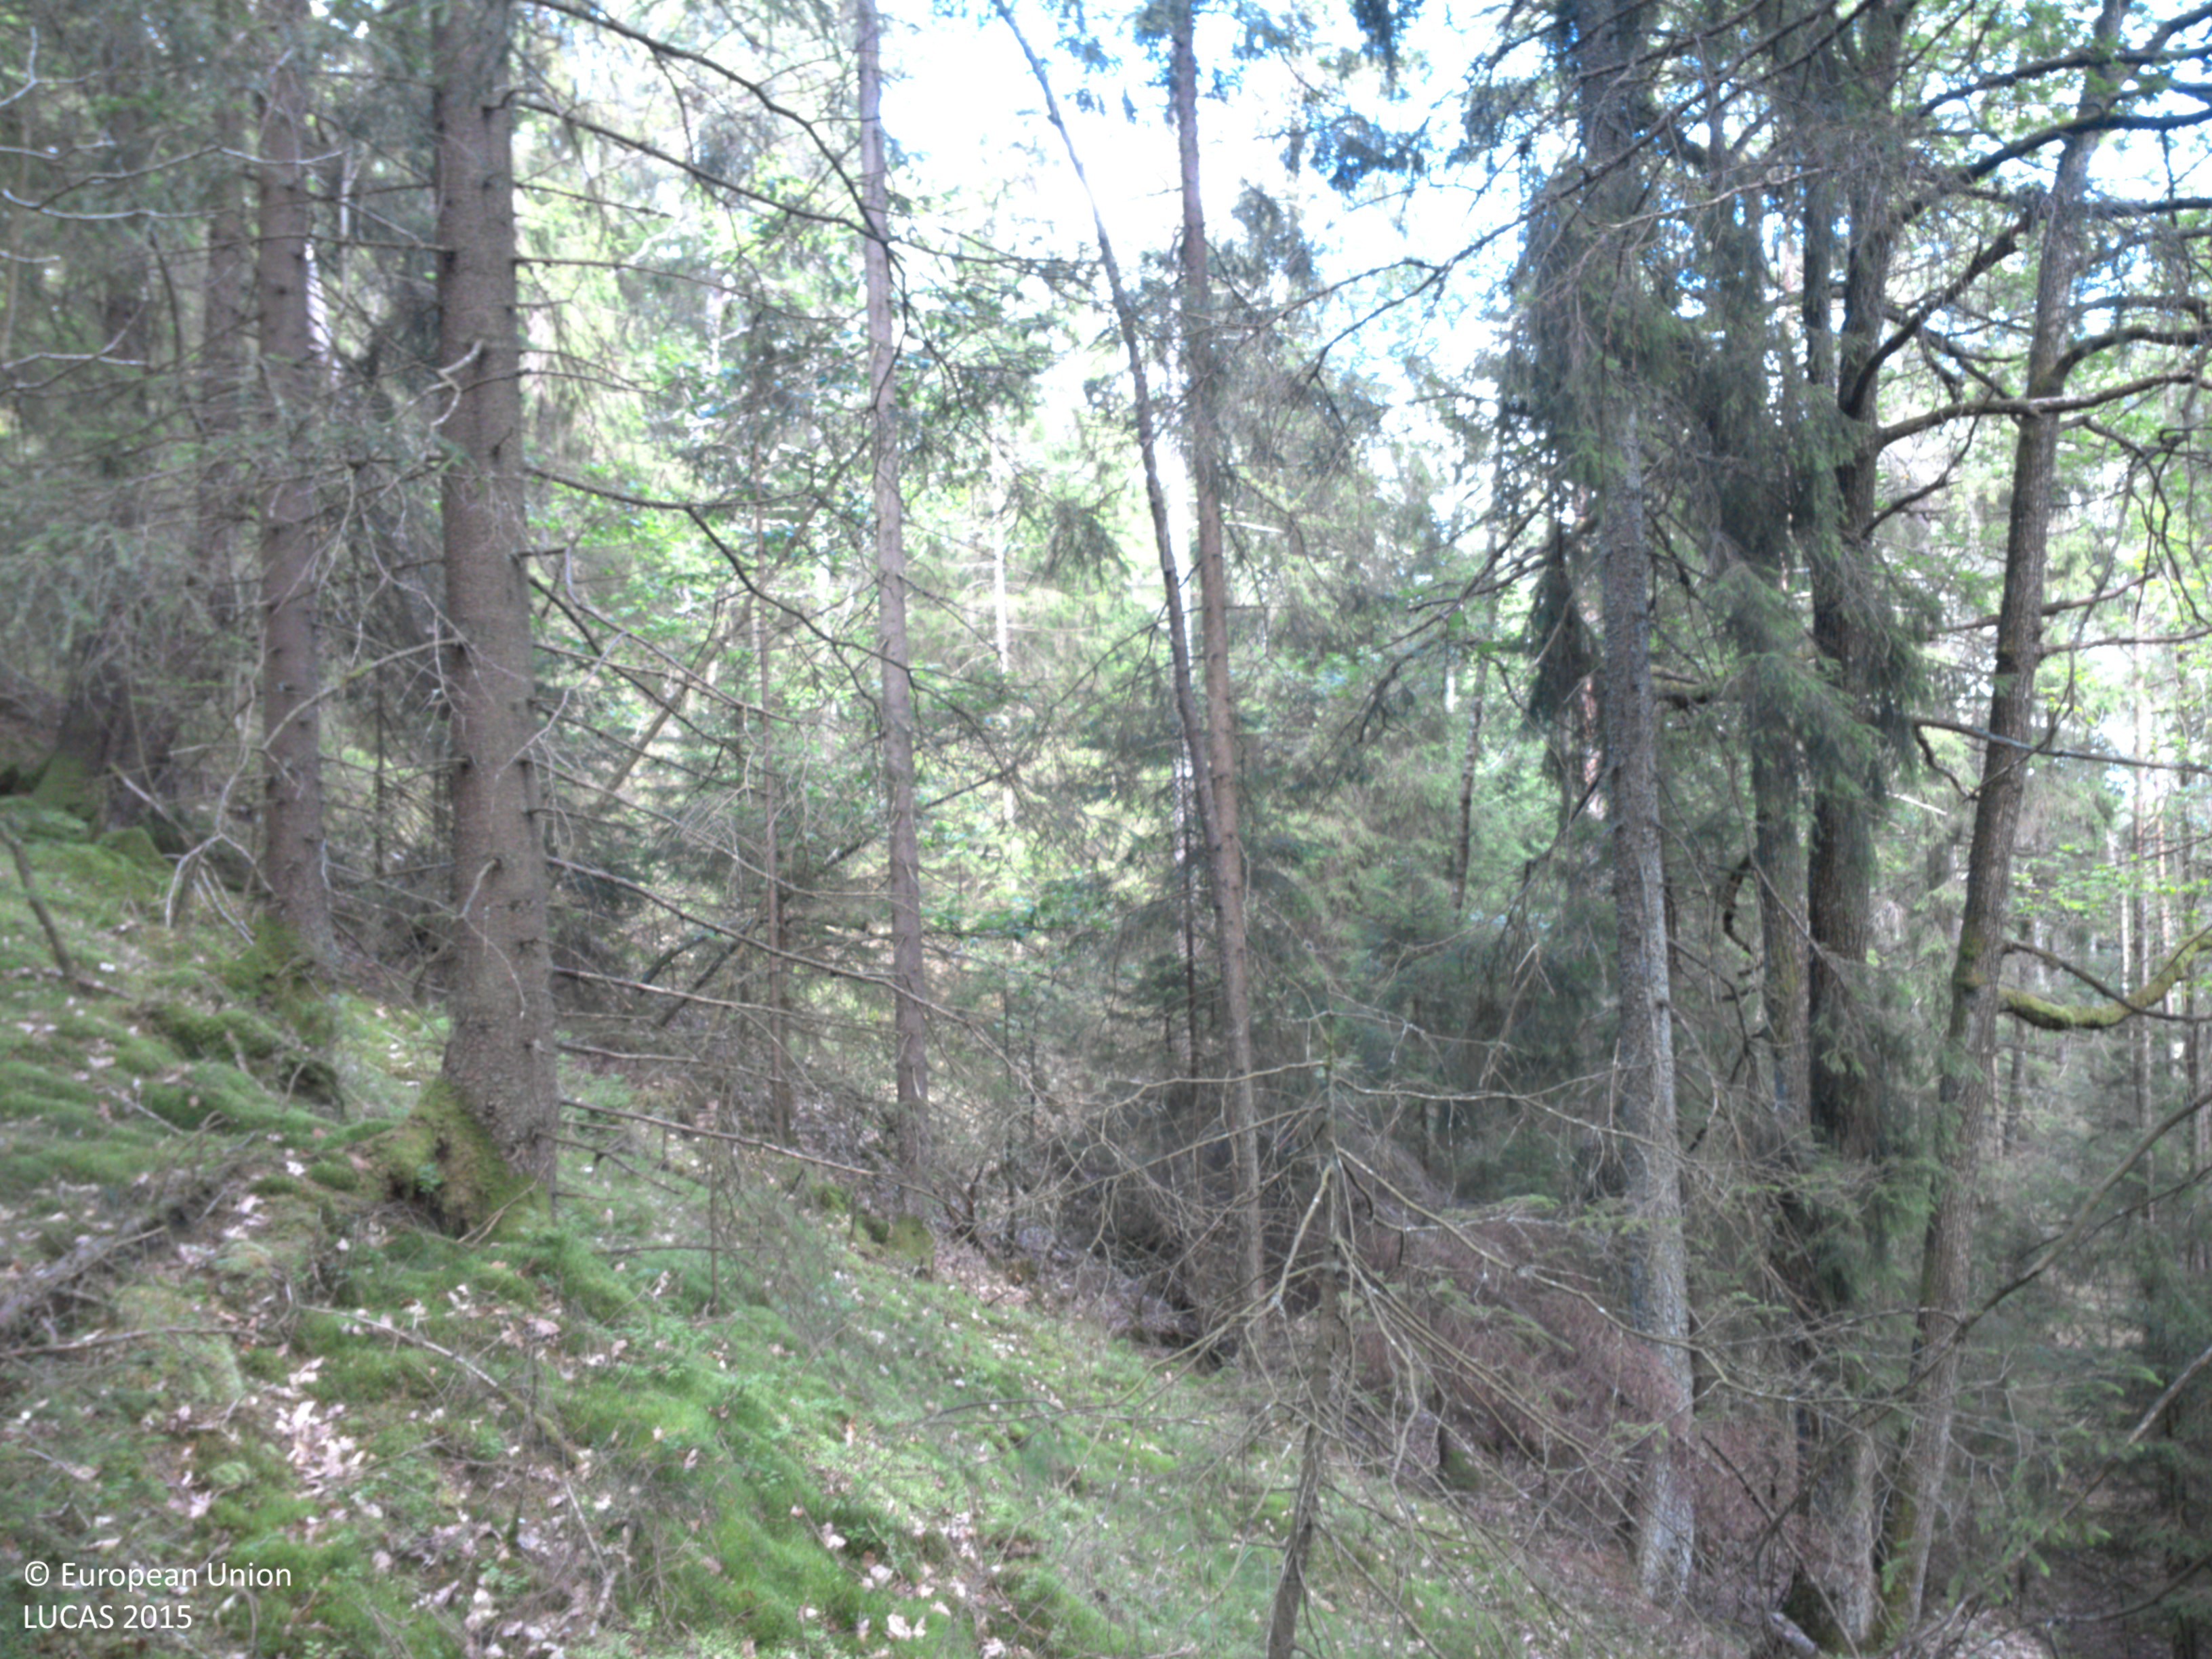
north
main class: Woodland
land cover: Spruce dominated coniferous woodland
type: boreal forest
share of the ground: 50 - 75 %
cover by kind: coniferous forest trees 60 %, herbaceous plants 25 %, shrubs 15 %
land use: Forestry
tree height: > 5 m
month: August
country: SE
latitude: 58.0430
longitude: 11.9783
